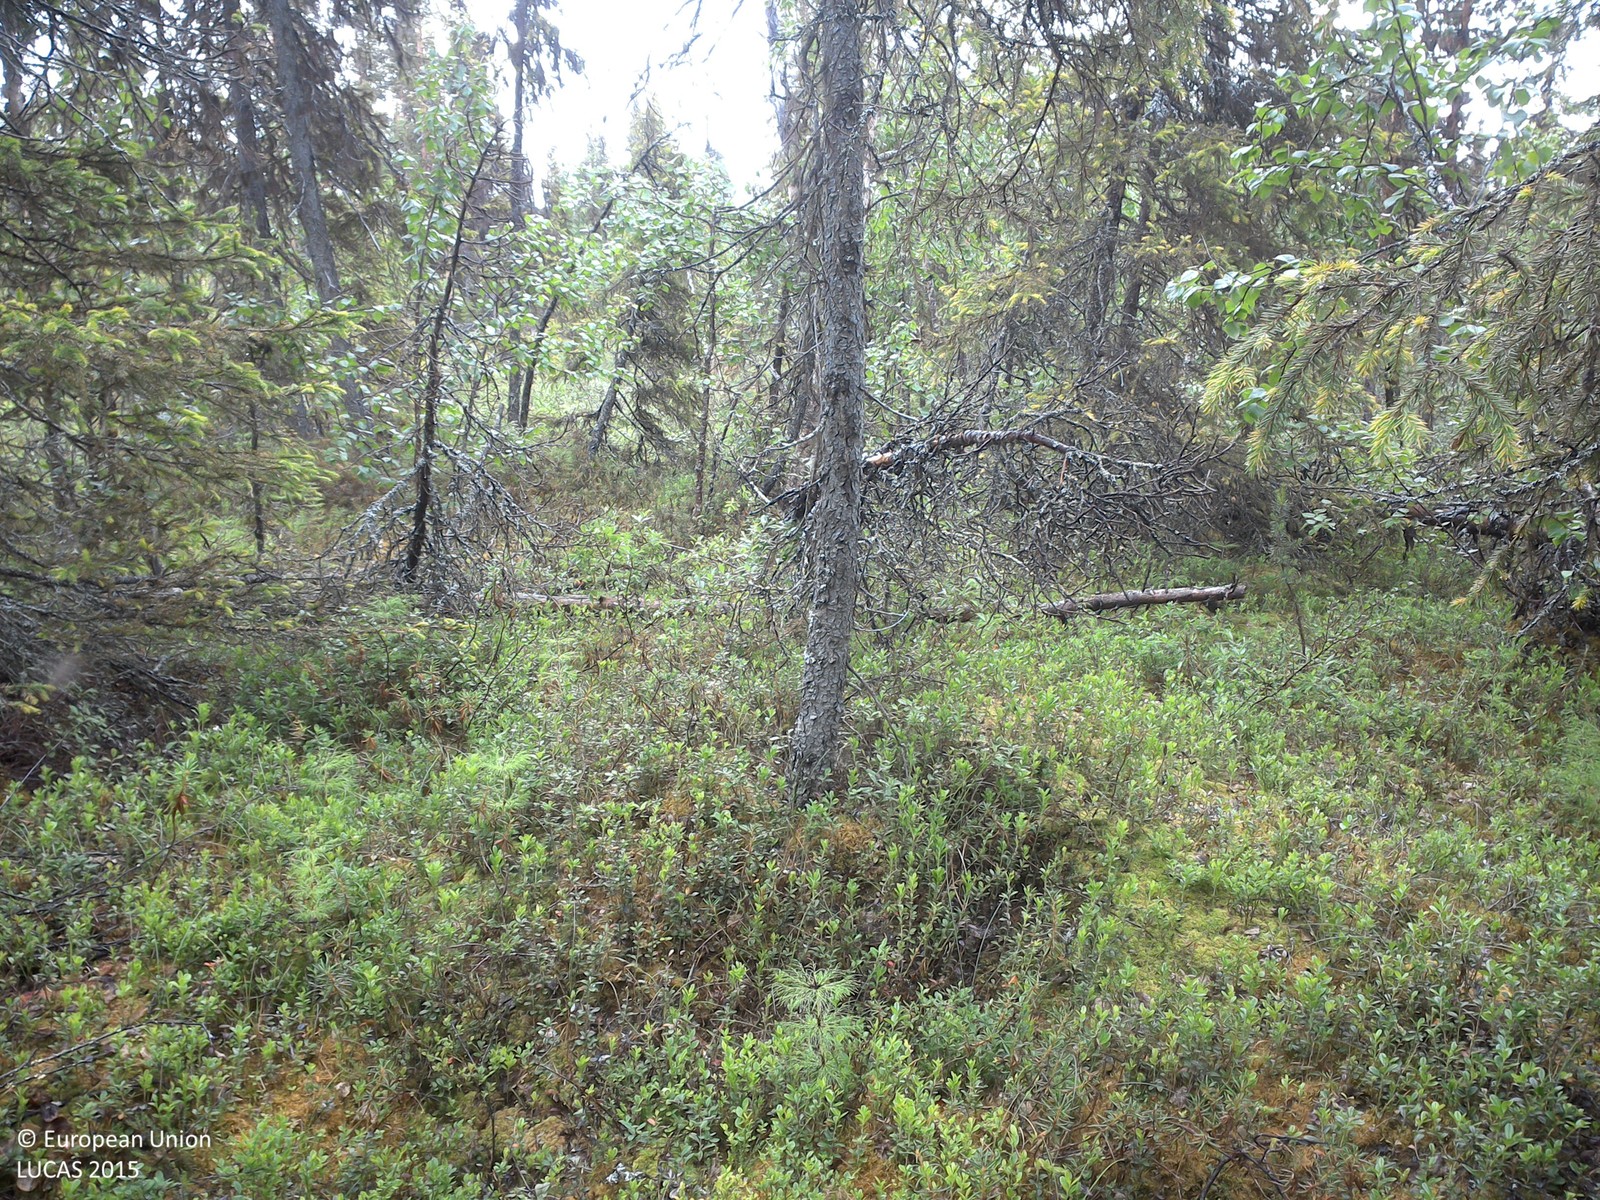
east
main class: Woodland
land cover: Spruce dominated mixed woodland
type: boreal forest
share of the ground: 25 - 50 %
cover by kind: shrubs 55 %, coniferous forest trees 25 %, broadleaved forest trees 15 %, lichens and mosses 5 %
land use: Forestry
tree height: > 5 m
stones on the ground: < 10 %
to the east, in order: Spruce dominated mixed woodland; Fences; Groves; Pine dominated mixed woodland; Inland fresh running water
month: July
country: SE
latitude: 67.8173
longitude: 23.4683
